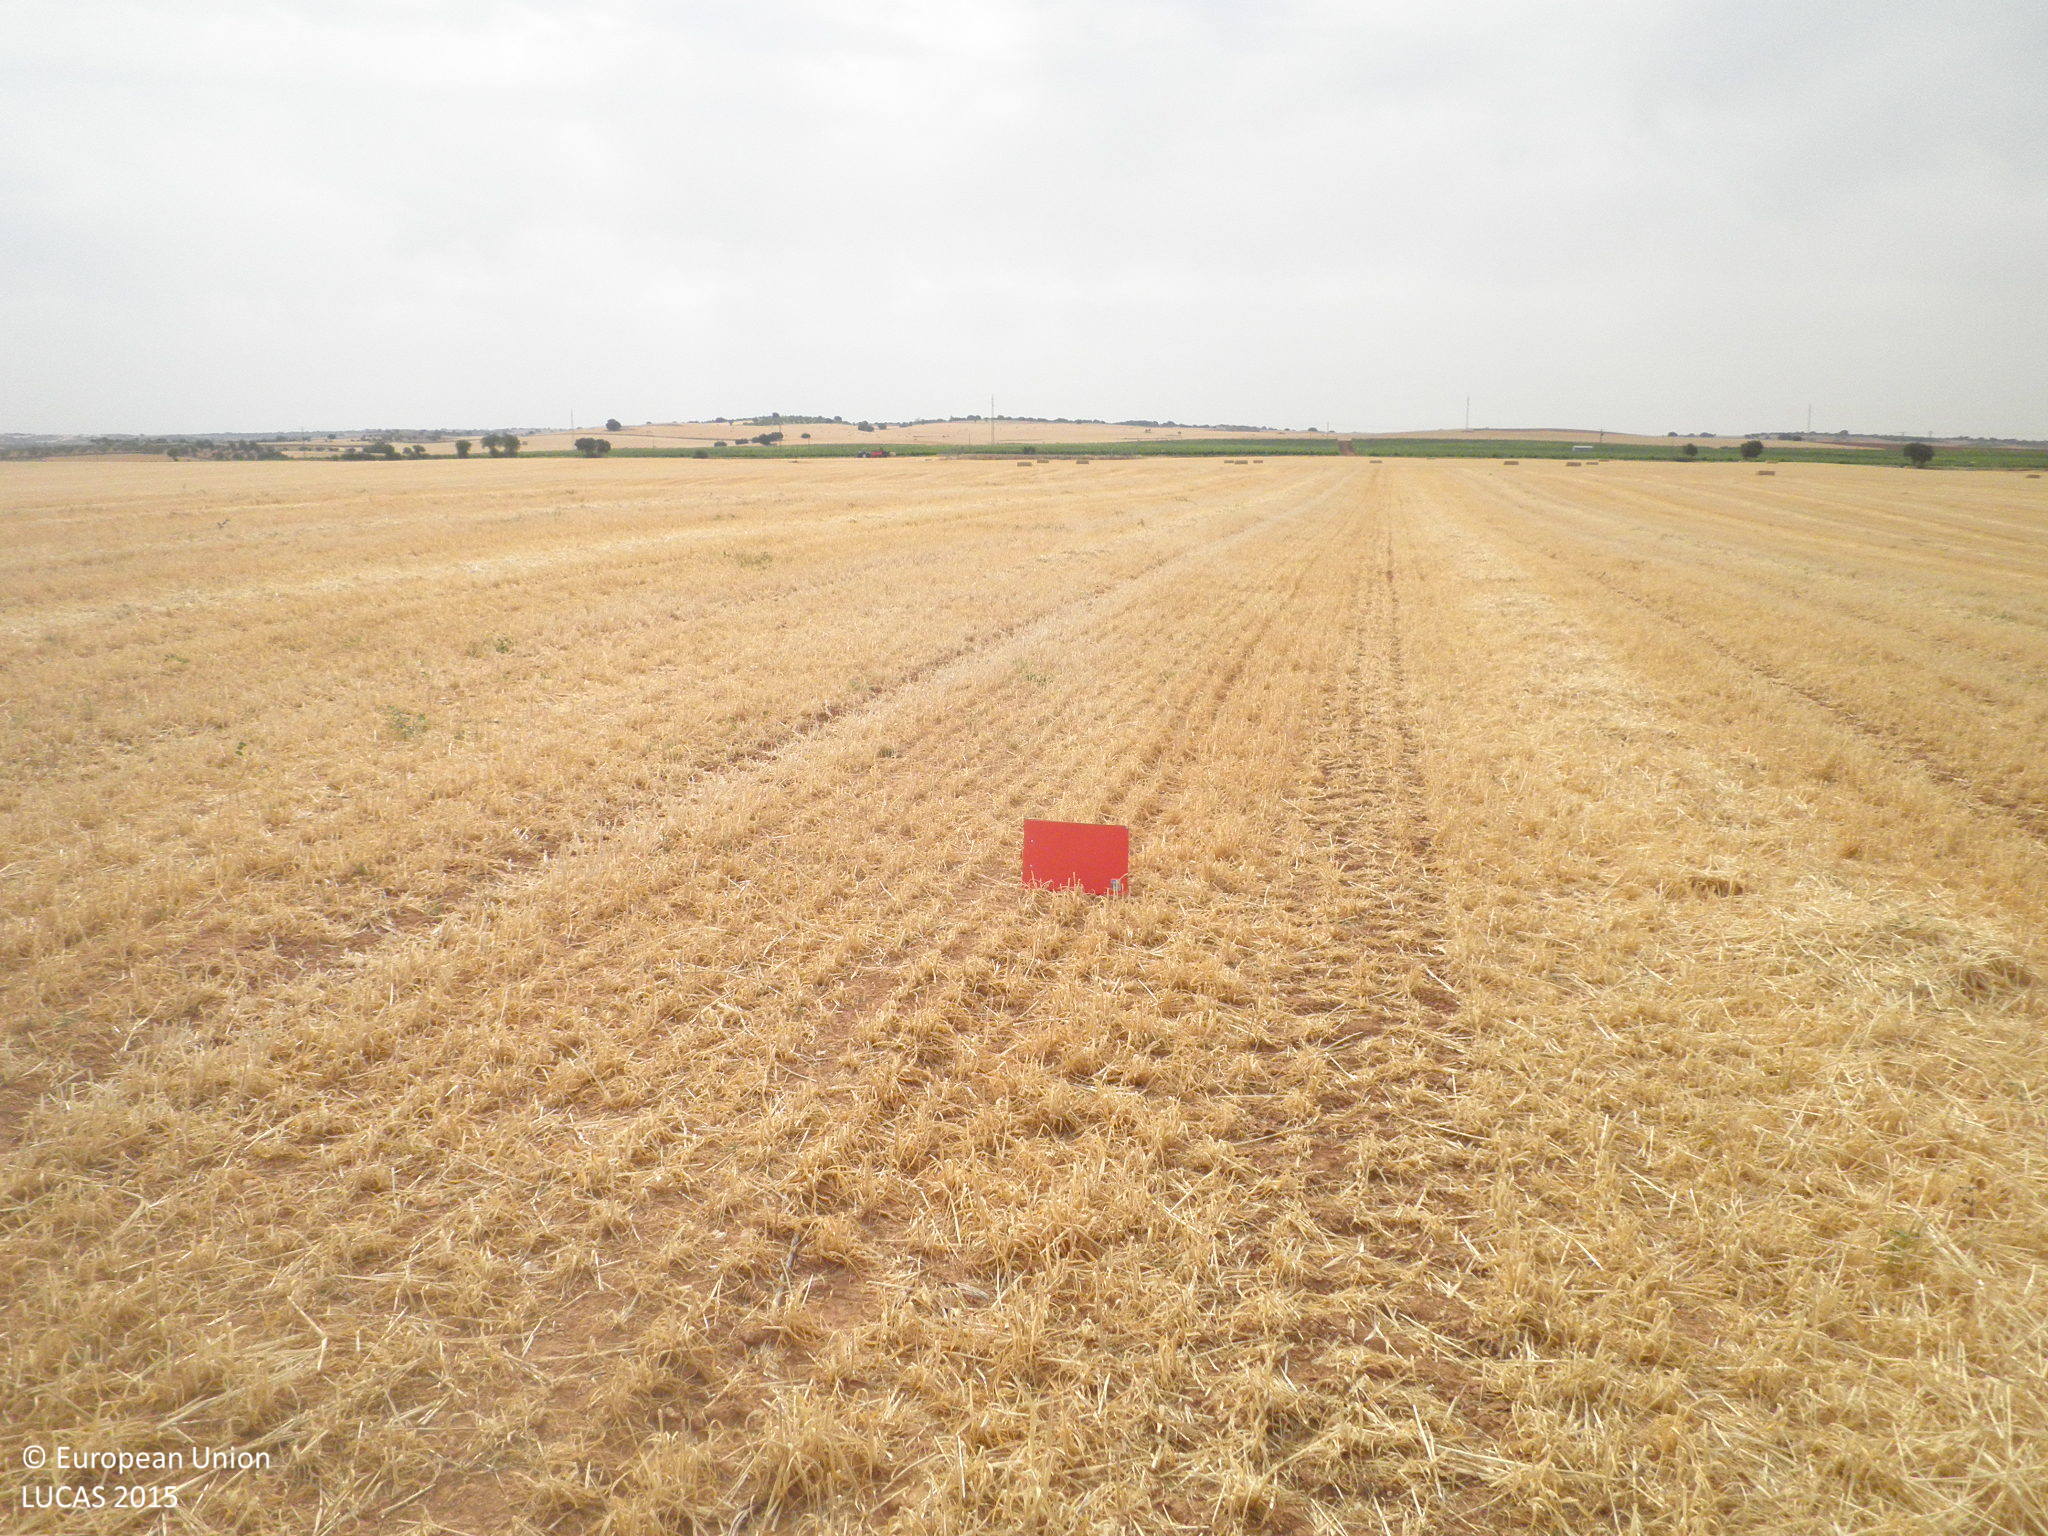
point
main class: Cropland
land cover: Barley
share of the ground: 50 - 75 %
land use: Agriculture (excluding fallow land and kitchen gardens)
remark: Harvested field
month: July
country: ES
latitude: 39.5259
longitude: -2.7298
